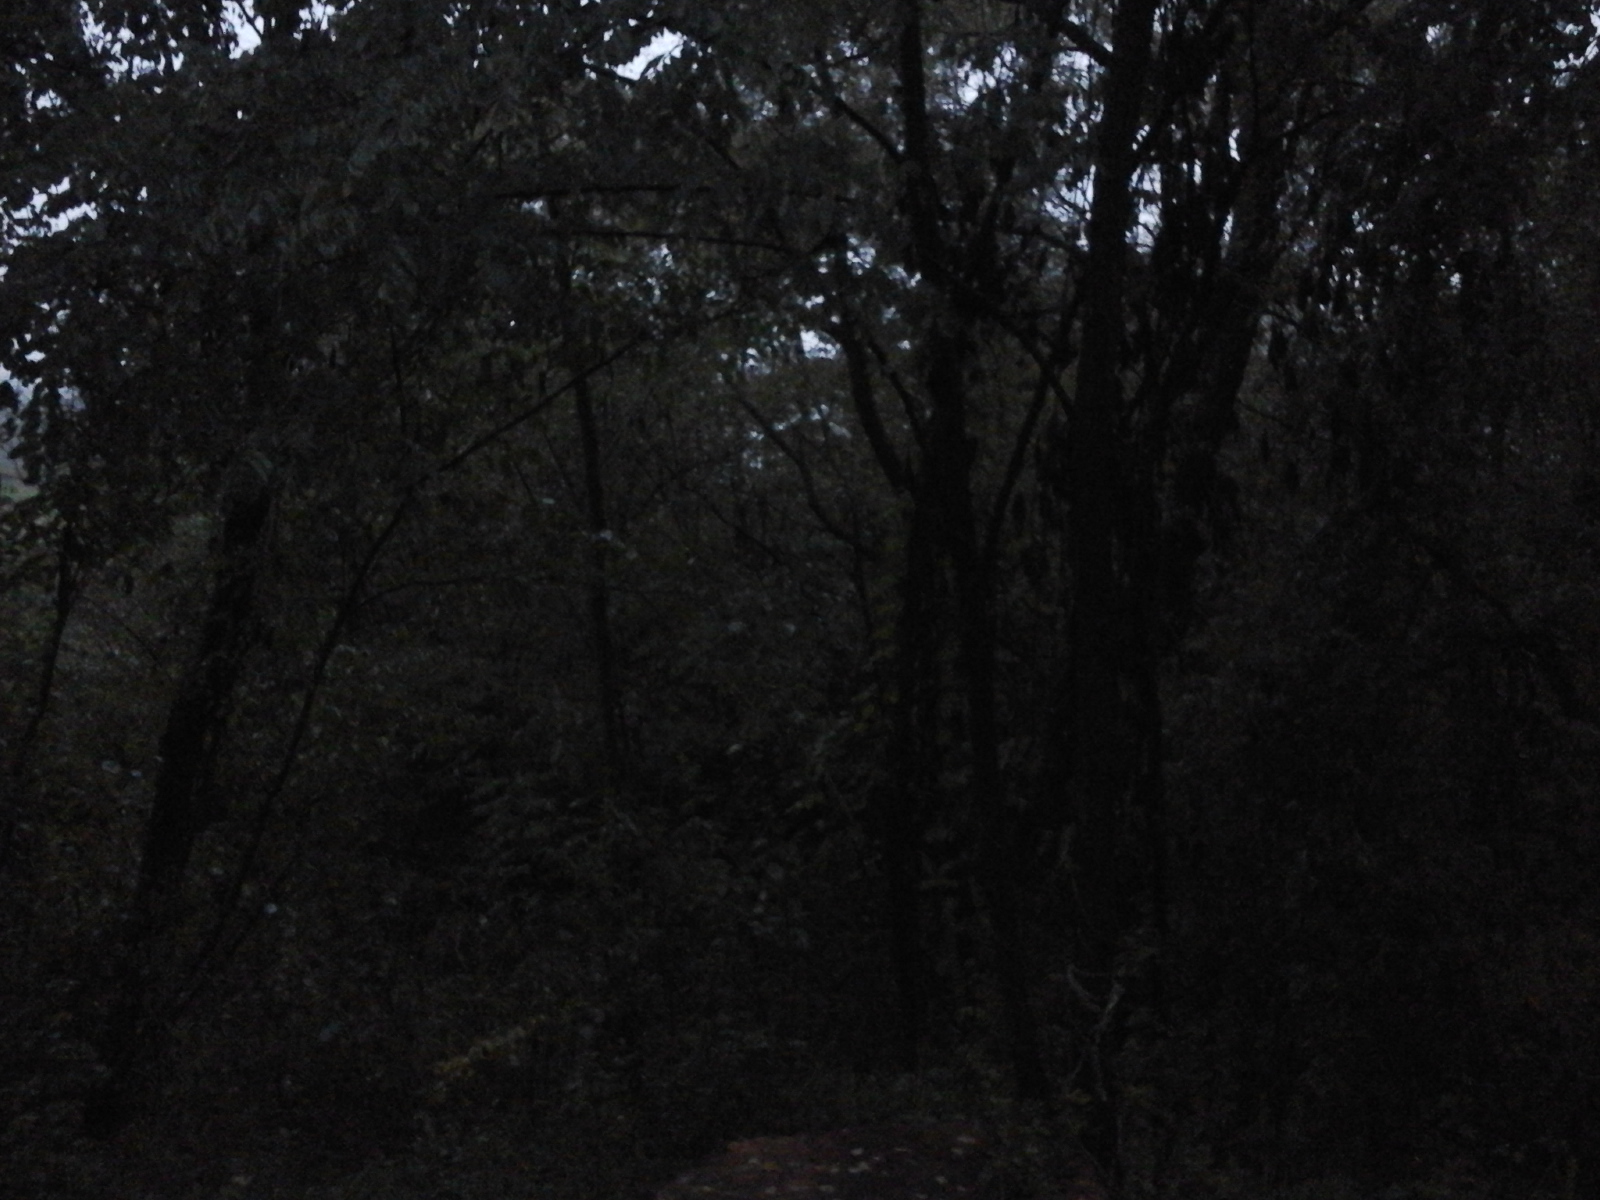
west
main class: Woodland
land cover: Broadleaved woodland
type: beech forest
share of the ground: > 75 %
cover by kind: broadleaved forest trees 100 %
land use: Forestry
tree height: > 5 m
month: September
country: RO
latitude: 44.9617
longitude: 23.6368
